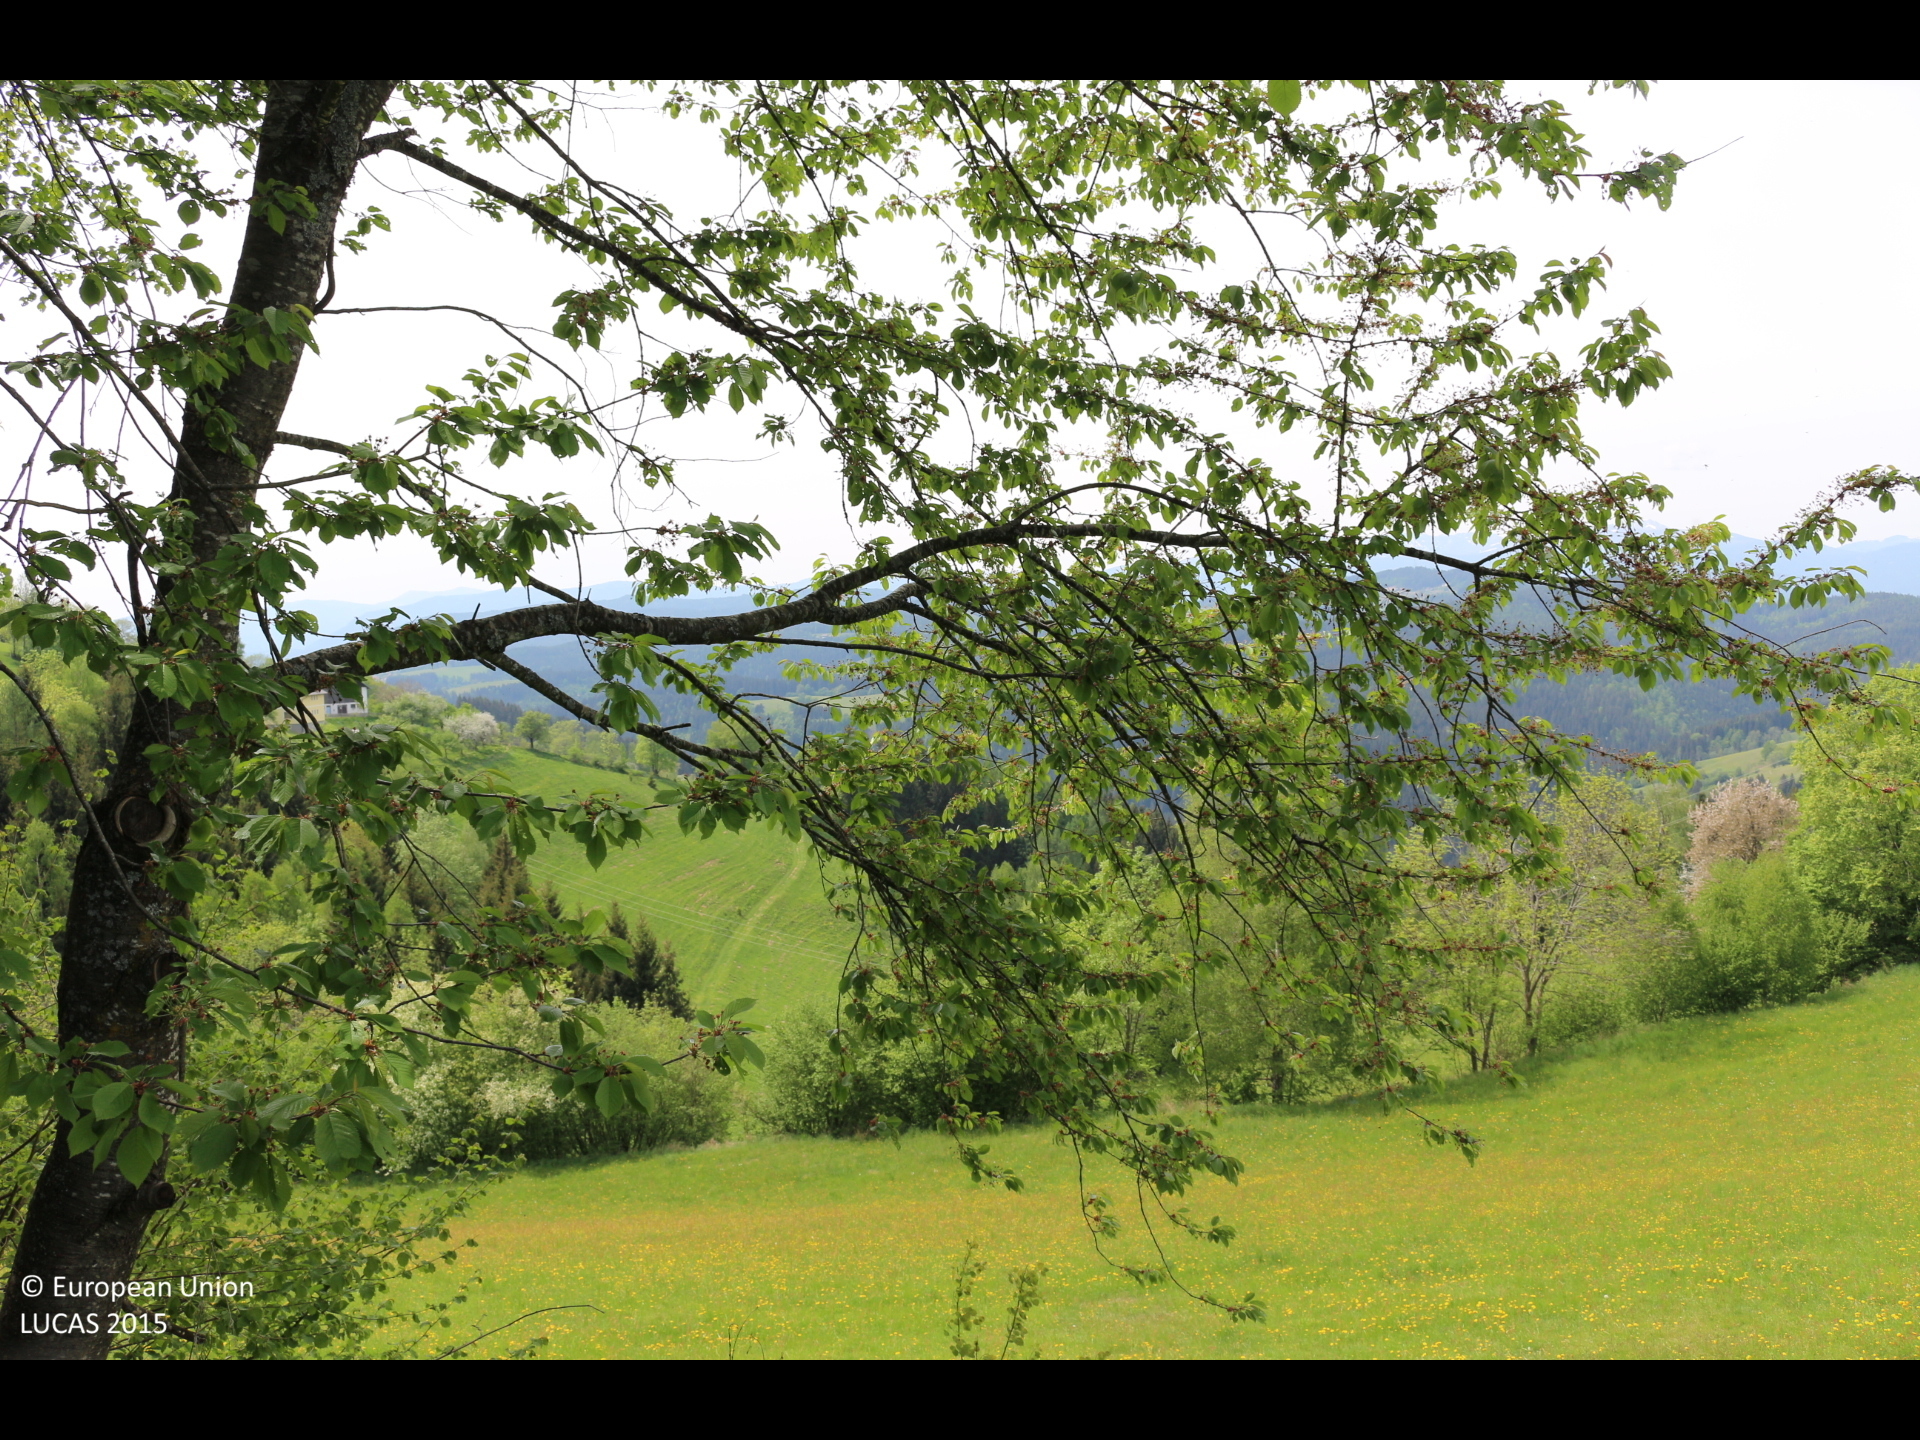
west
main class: Woodland
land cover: Broadleaved woodland
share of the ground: 50 - 75 %
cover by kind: broadleaved forest trees 75 %, herbaceous plants 15 %, shrubs 10 %
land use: Forestry
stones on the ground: < 10 %
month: May
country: AT
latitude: 46.8086
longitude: 14.2305
